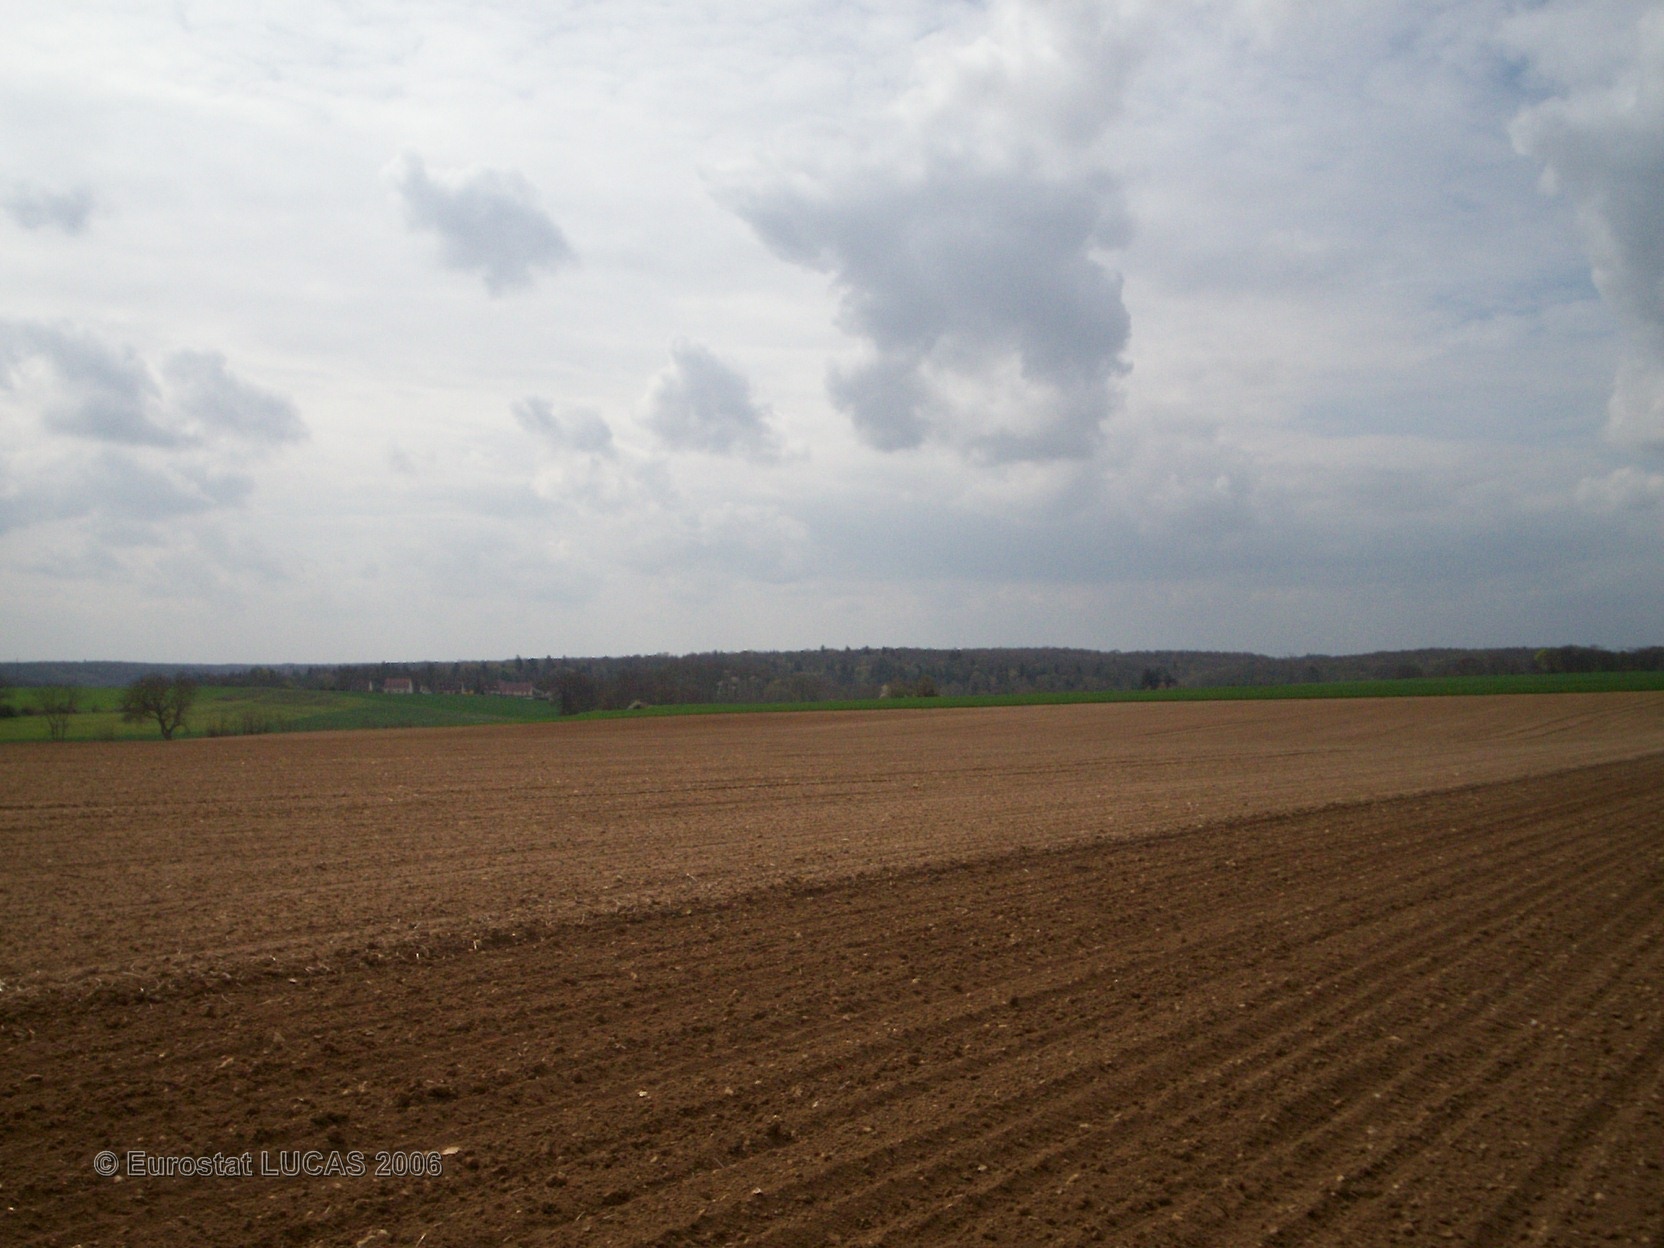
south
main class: Cropland
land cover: Sugar beet
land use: Agriculture (excluding fallow land and kitchen gardens)
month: April
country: FR
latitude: 48.2471
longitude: 2.8948
